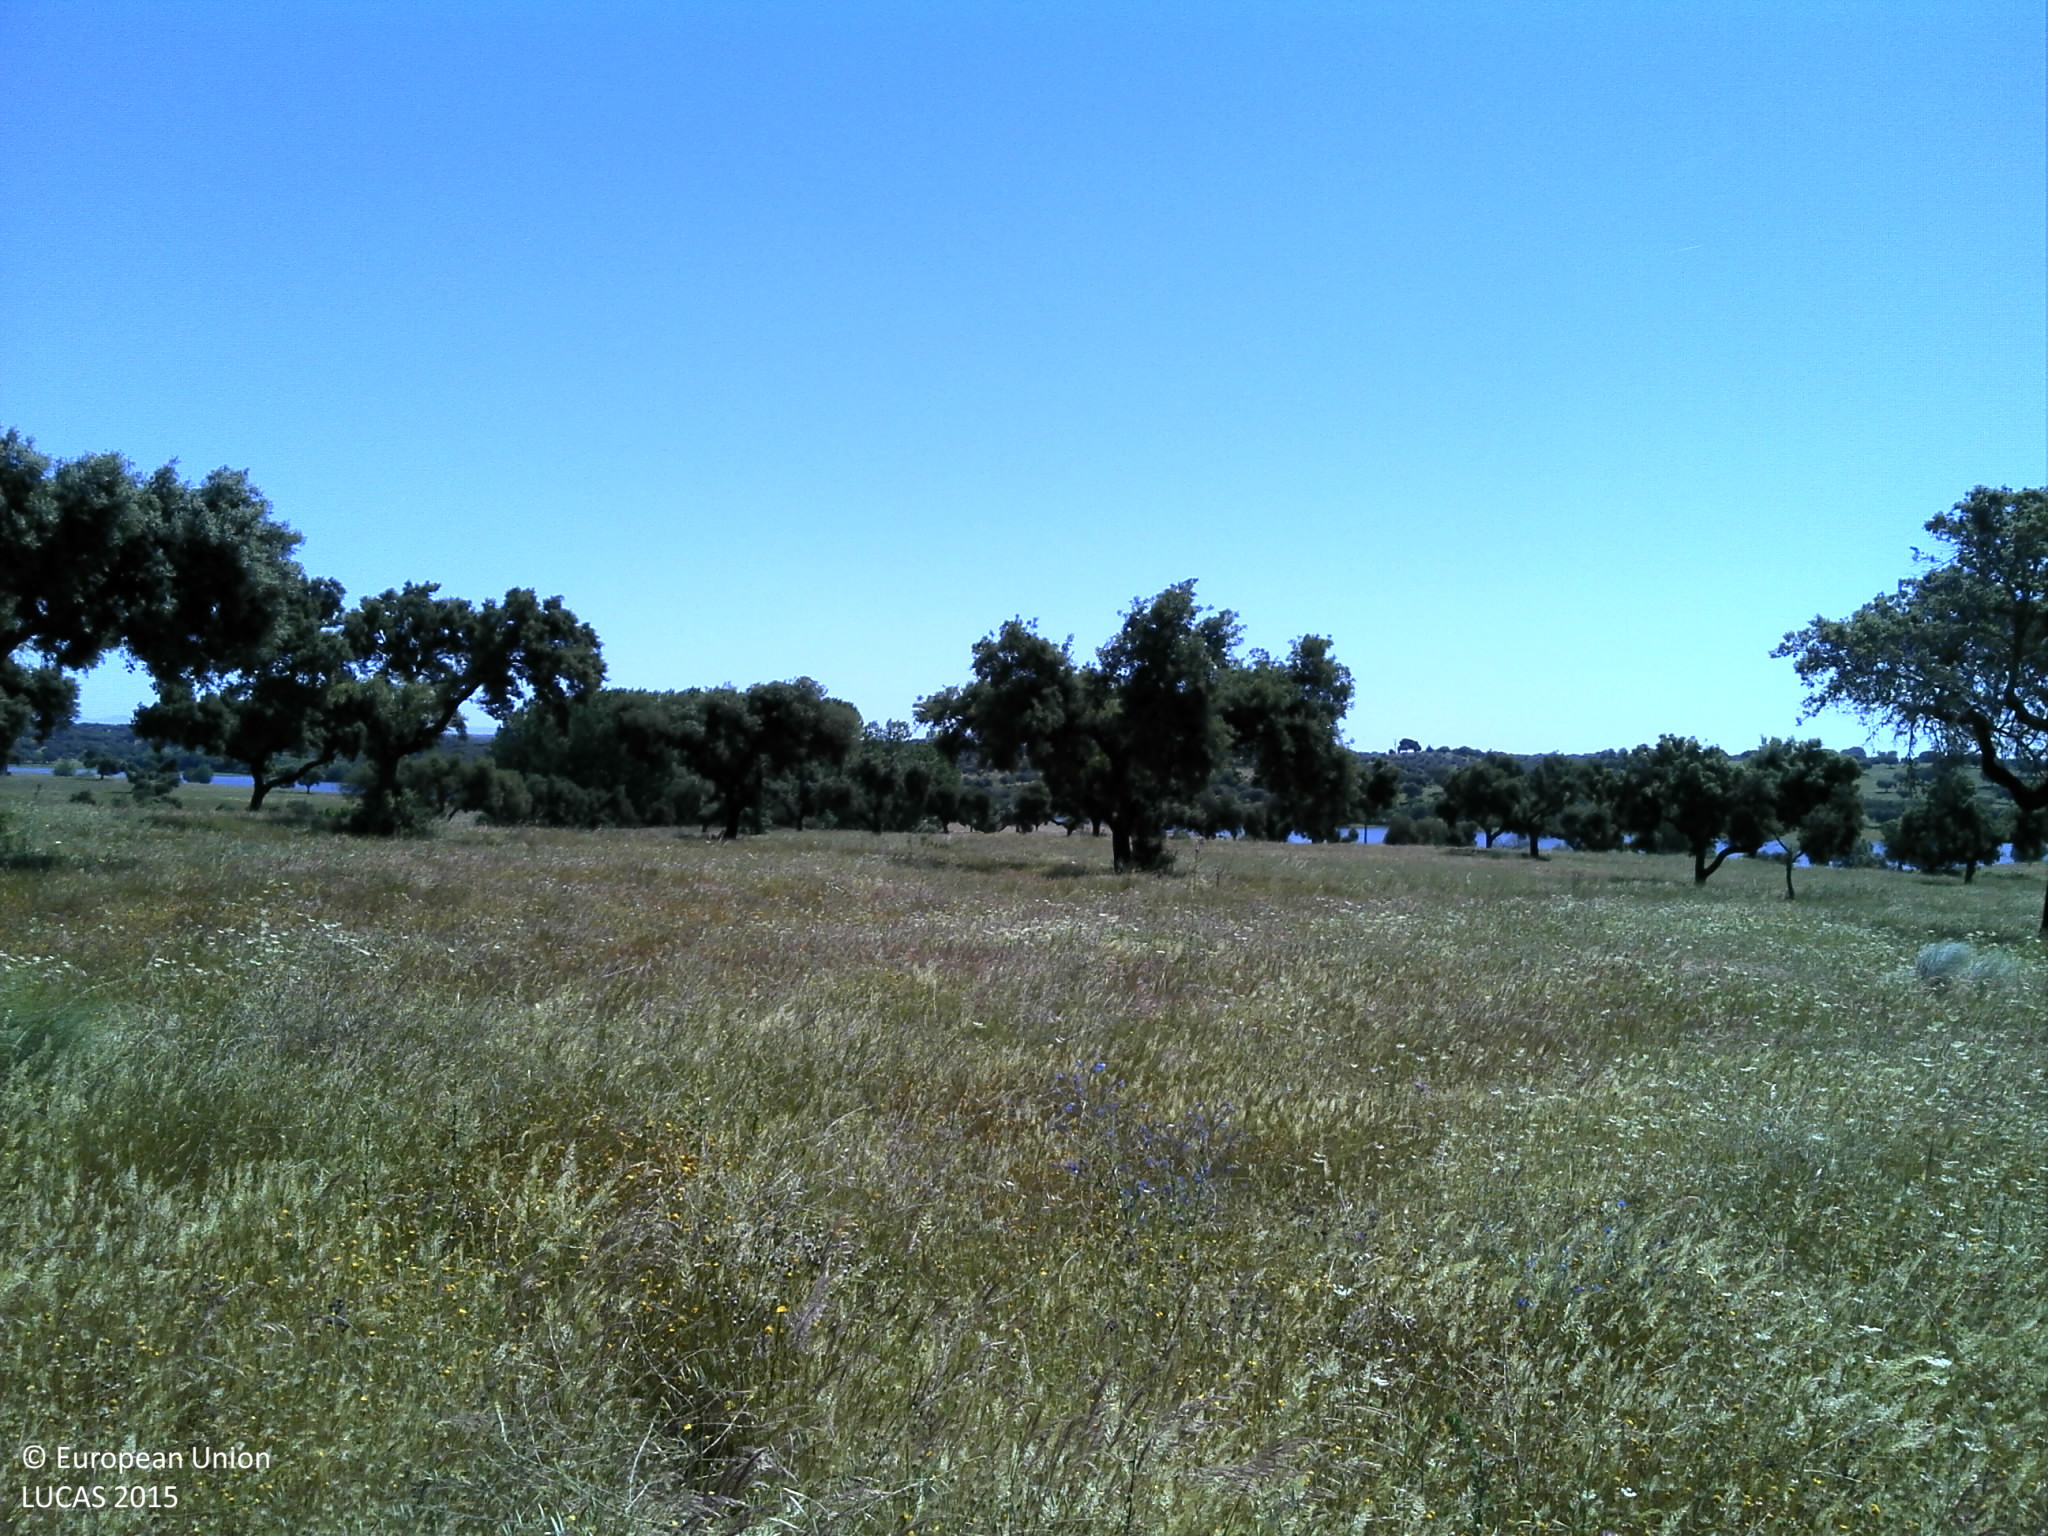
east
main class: Grassland
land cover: Grassland with sparse tree/shrub cover
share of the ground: > 75 %
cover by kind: herbaceous plants 90 %, broadleaved forest trees 5 %, unconsolidated bare surface 5 %
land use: Agriculture (excluding fallow land and kitchen gardens)
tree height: > 5 m
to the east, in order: Grassland with sparse tree/shrub cover; Grassland without tree/shrub cover; Broadleaved woodland; Grassland without tree/shrub cover; Broadleaved woodland
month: May
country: PT
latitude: 39.1499
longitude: -7.8571
